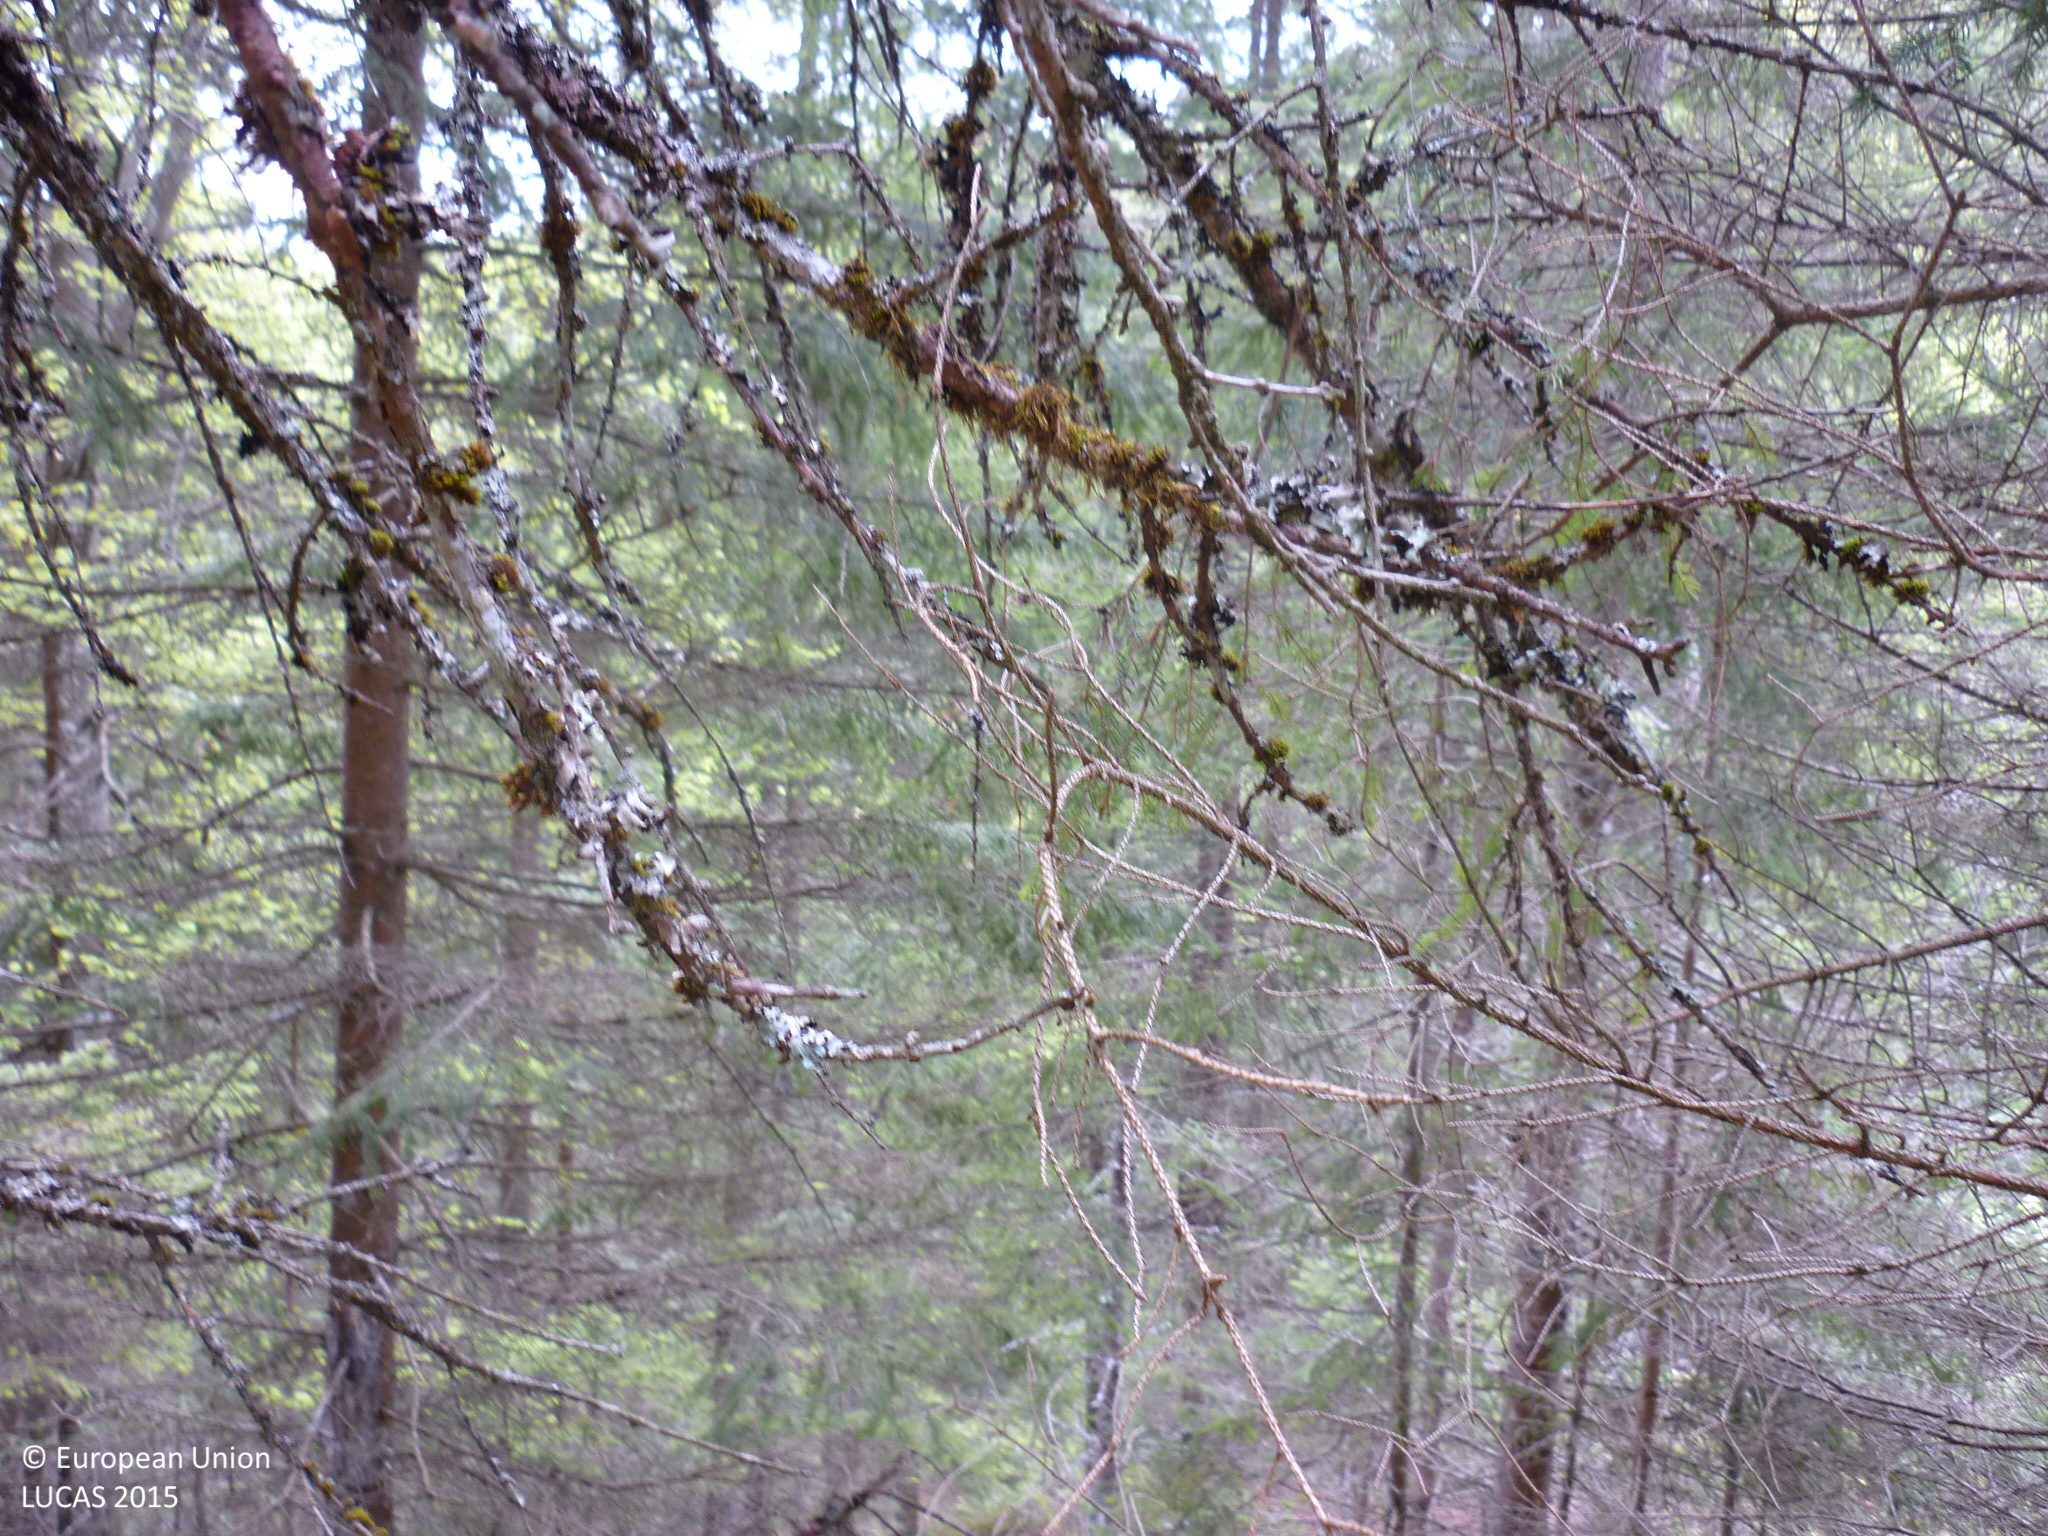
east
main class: Woodland
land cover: Spruce dominated mixed woodland
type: mountainous beech forest
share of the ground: > 75 %
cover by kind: coniferous forest trees 70 %, broadleaved forest trees 25 %, herbaceous plants 5 %
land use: Forestry
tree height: > 5 m
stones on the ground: < 10 %
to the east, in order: Spruce dominated mixed woodland; Rivers and streams; Spruce dominated mixed woodland
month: May
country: AT
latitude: 47.6956
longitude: 14.9970
